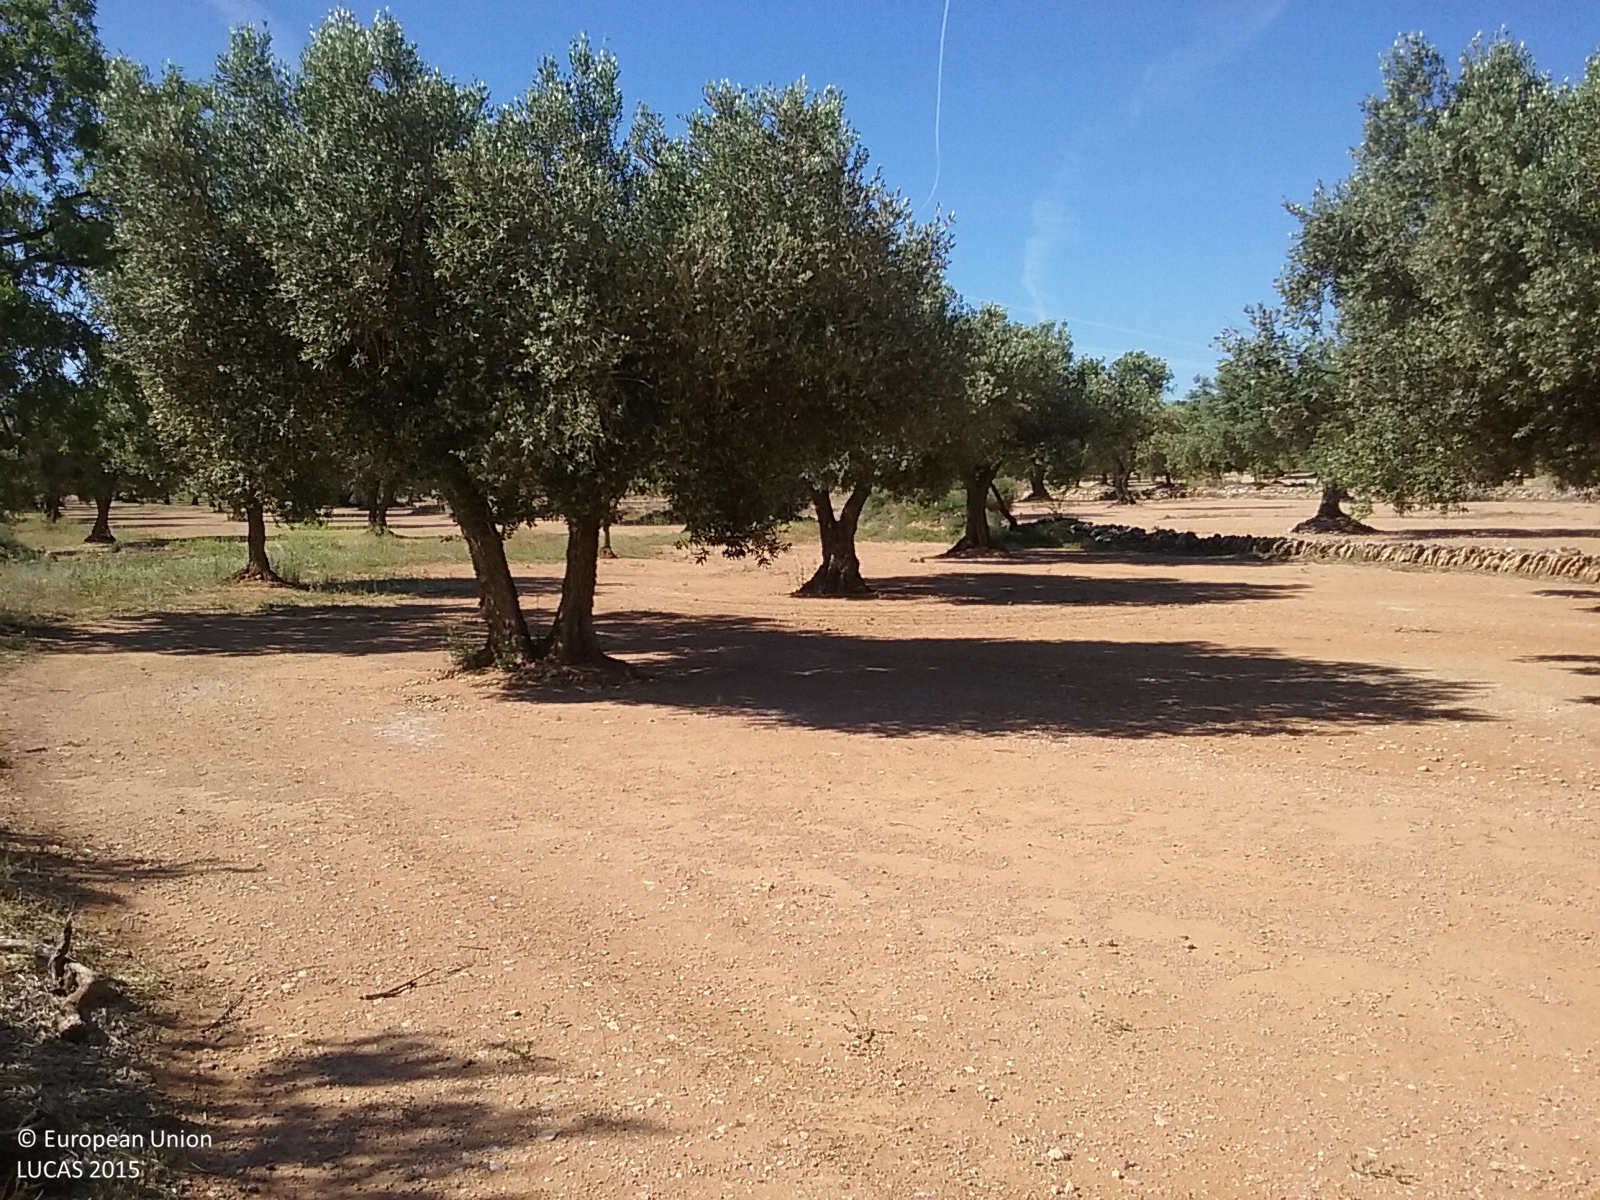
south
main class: Cropland
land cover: Olive groves
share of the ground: 25 - 50 %
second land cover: Other bare soil
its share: > 75 %
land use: Agriculture (excluding fallow land and kitchen gardens)
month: May
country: ES
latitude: 40.5052
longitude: 0.2125
